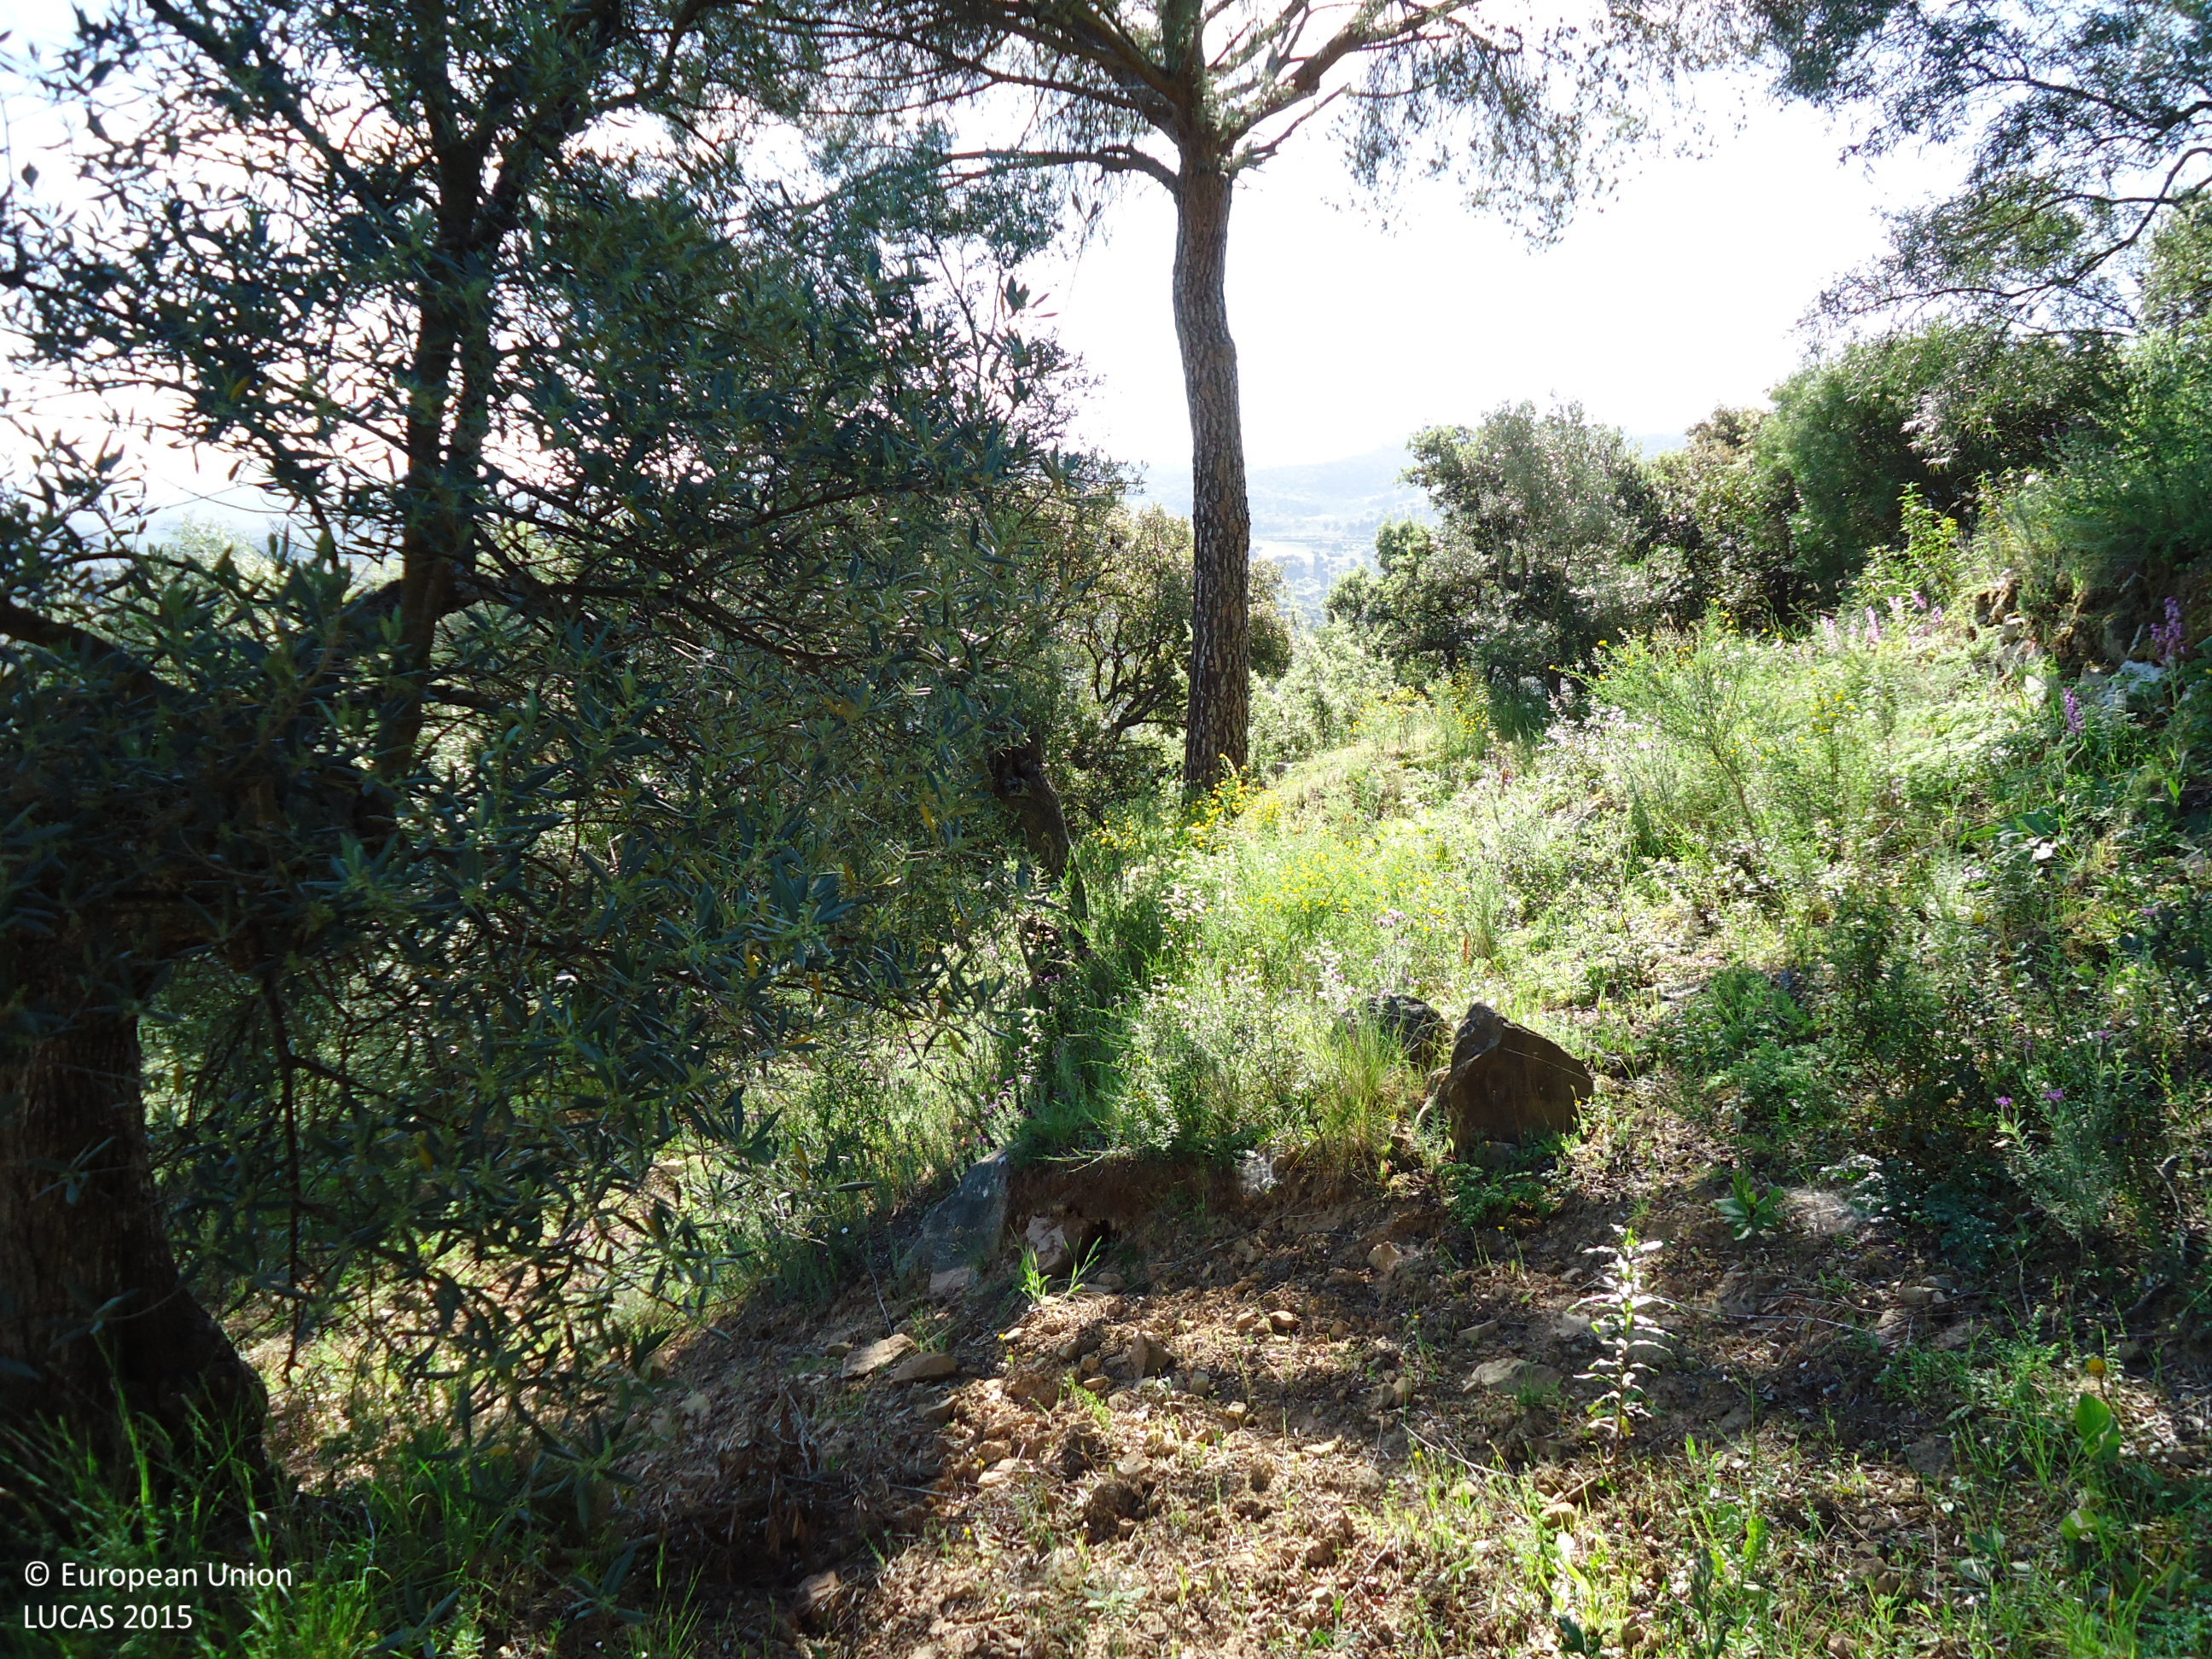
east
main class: Cropland
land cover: Olive groves
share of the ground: 50 - 75 %
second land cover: Other bare soil
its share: > 75 %
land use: Agriculture (excluding fallow land and kitchen gardens)
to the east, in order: Olive groves; Other bare soil; Shrubland with sparse tree cover; Grassland with sparse tree/shrub cover; Permanent crops (only in case pi)
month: May
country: ES
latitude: 36.8637
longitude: -5.3375
